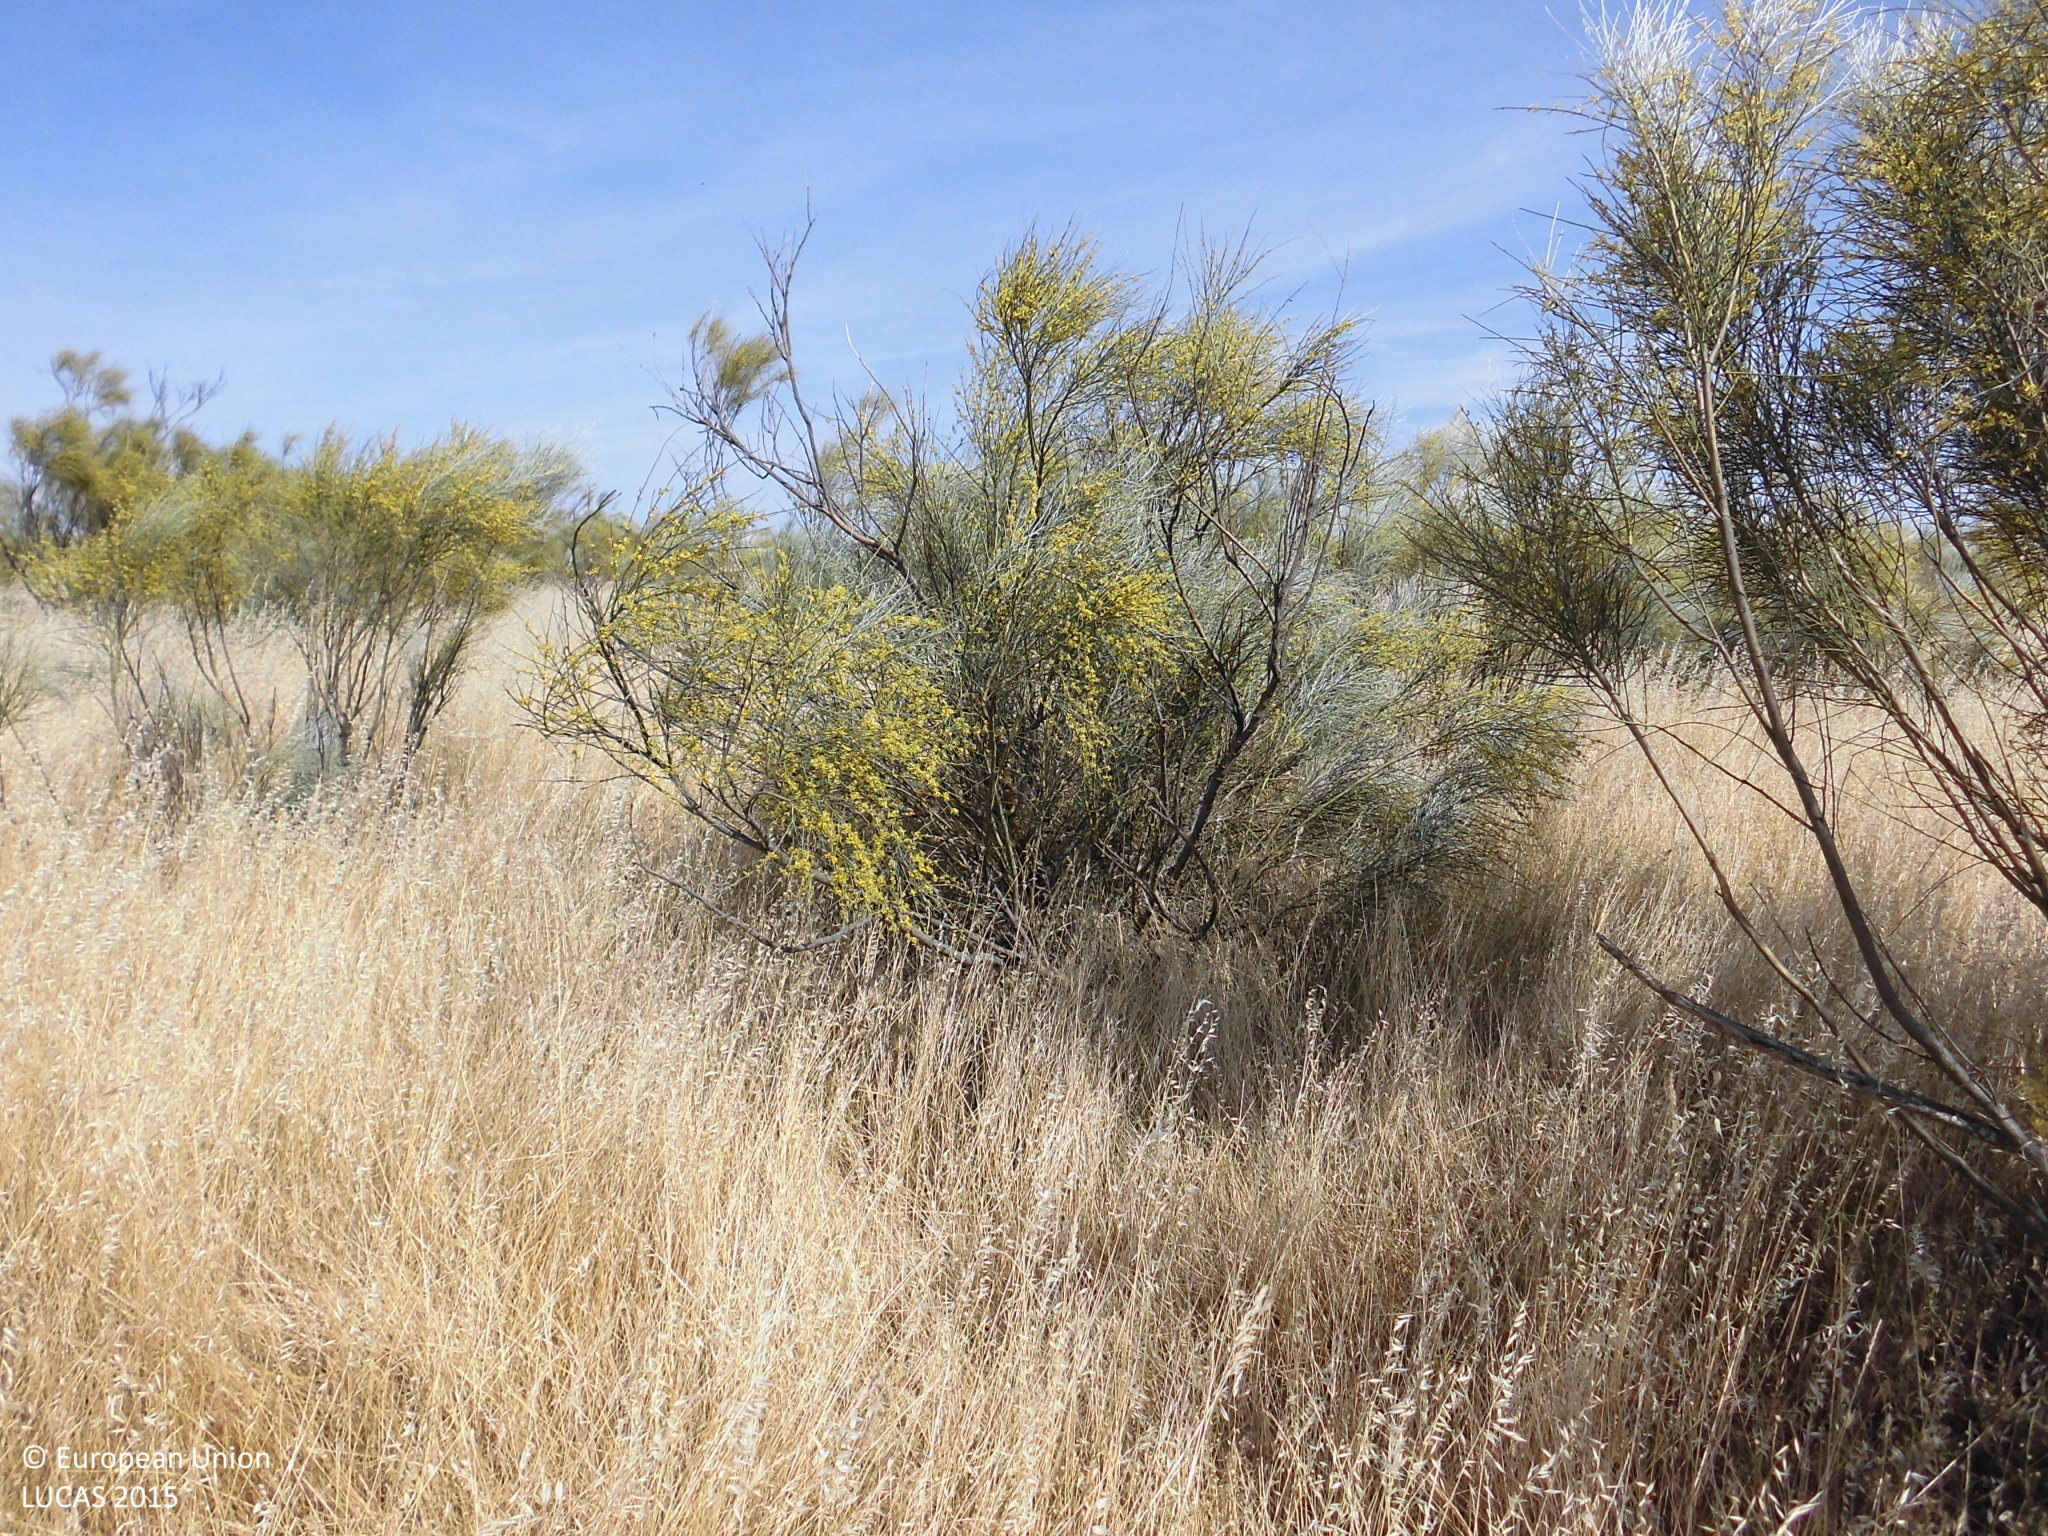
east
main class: Shrubland
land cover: Shrubland without tree cover
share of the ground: 10 - 25 %
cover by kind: herbaceous plants 85 %, shrubs 15 %
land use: Semi-natural and natural areas not in use
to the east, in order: Shrubland without tree cover; Tracks; Shrubland without tree cover
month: May
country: ES
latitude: 39.4608
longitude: -5.9947
